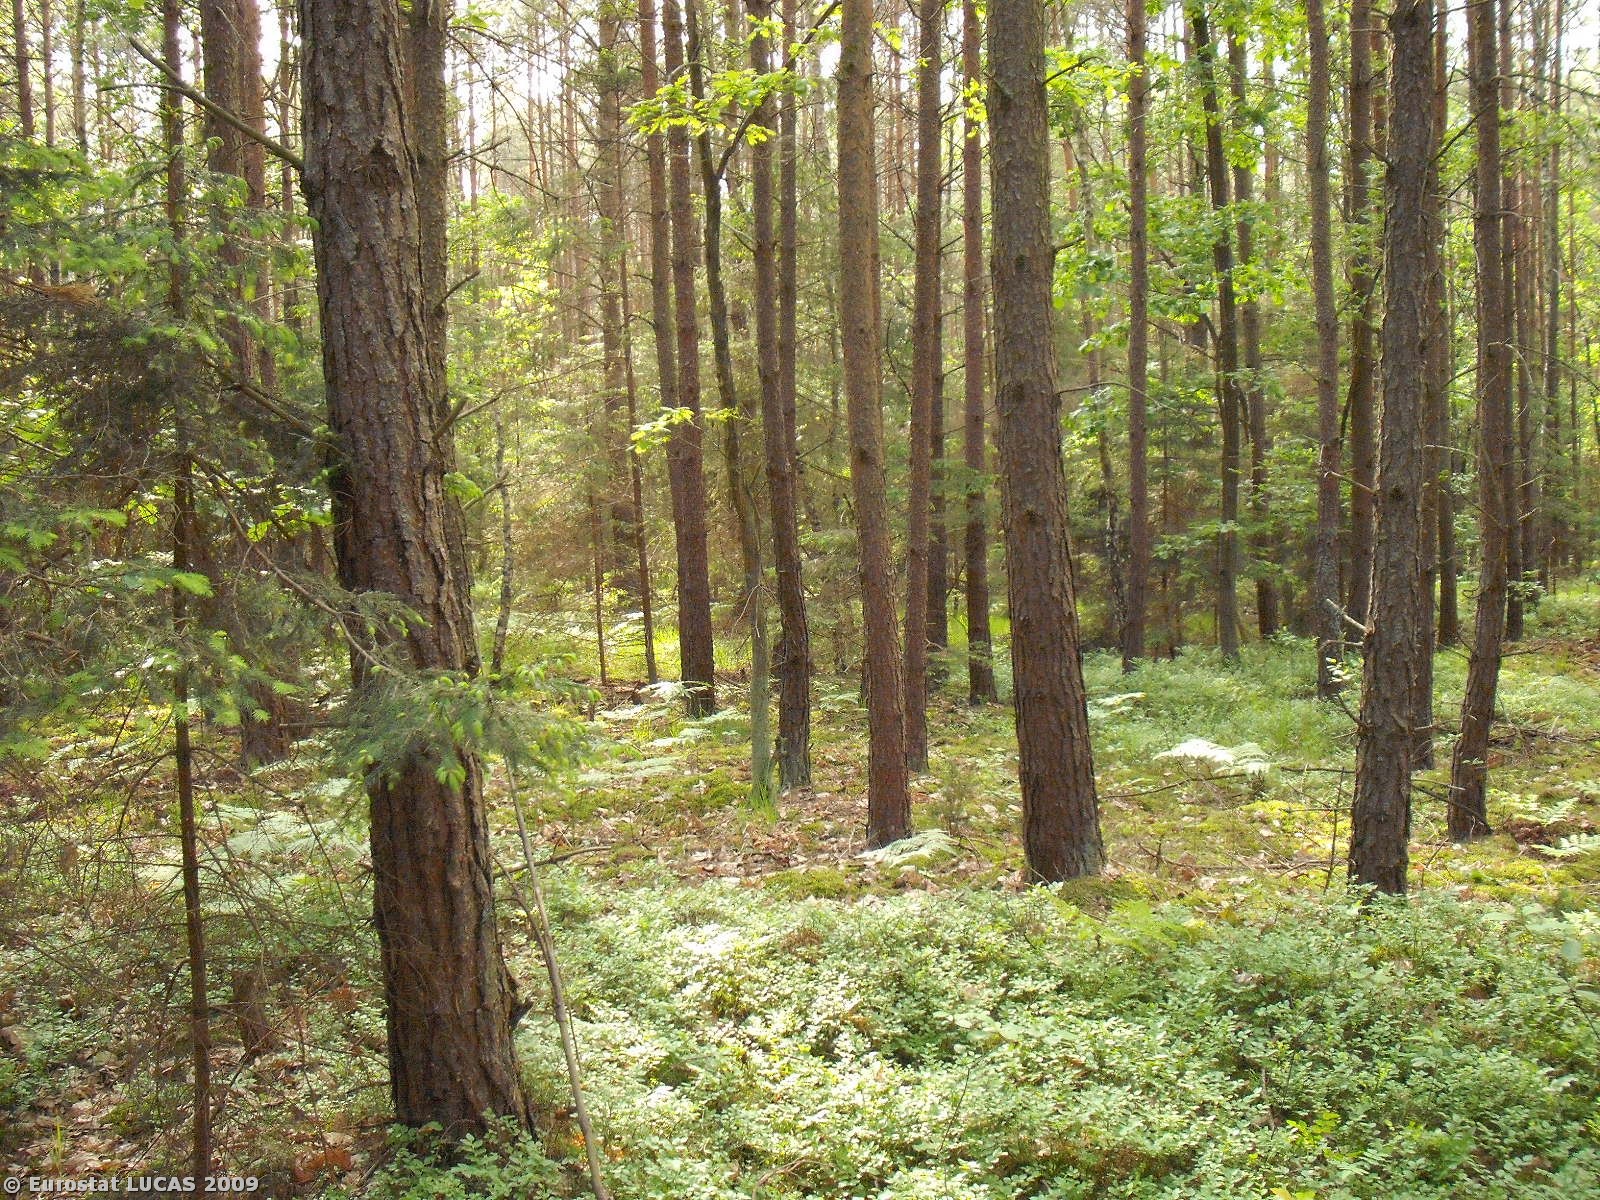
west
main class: Woodland
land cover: Coniferous woodland
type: hemiboreal forest and nemoral coniferous forest and mixed broadleaved-coniferous forest
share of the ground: > 75 %
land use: Forestry
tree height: > 5 m
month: June
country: PL
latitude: 51.3301
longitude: 20.5010
